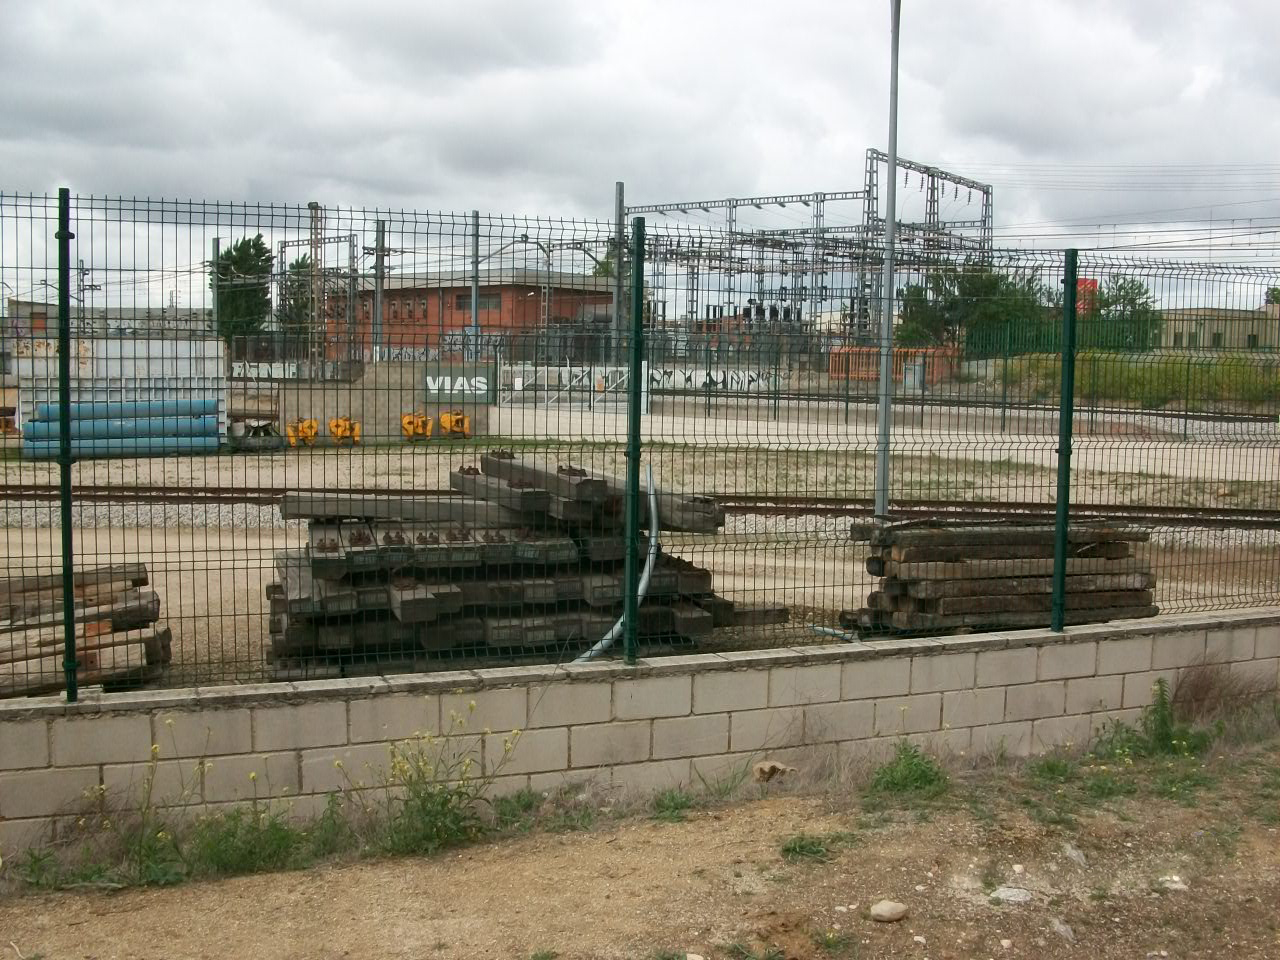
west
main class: Shrubland
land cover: Shrubland without tree cover
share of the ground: > 75 %
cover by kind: shrubs 95 %, herbaceous plants 5 %
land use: Abandoned areas
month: April
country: ES
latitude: 40.2751
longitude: -3.8088
